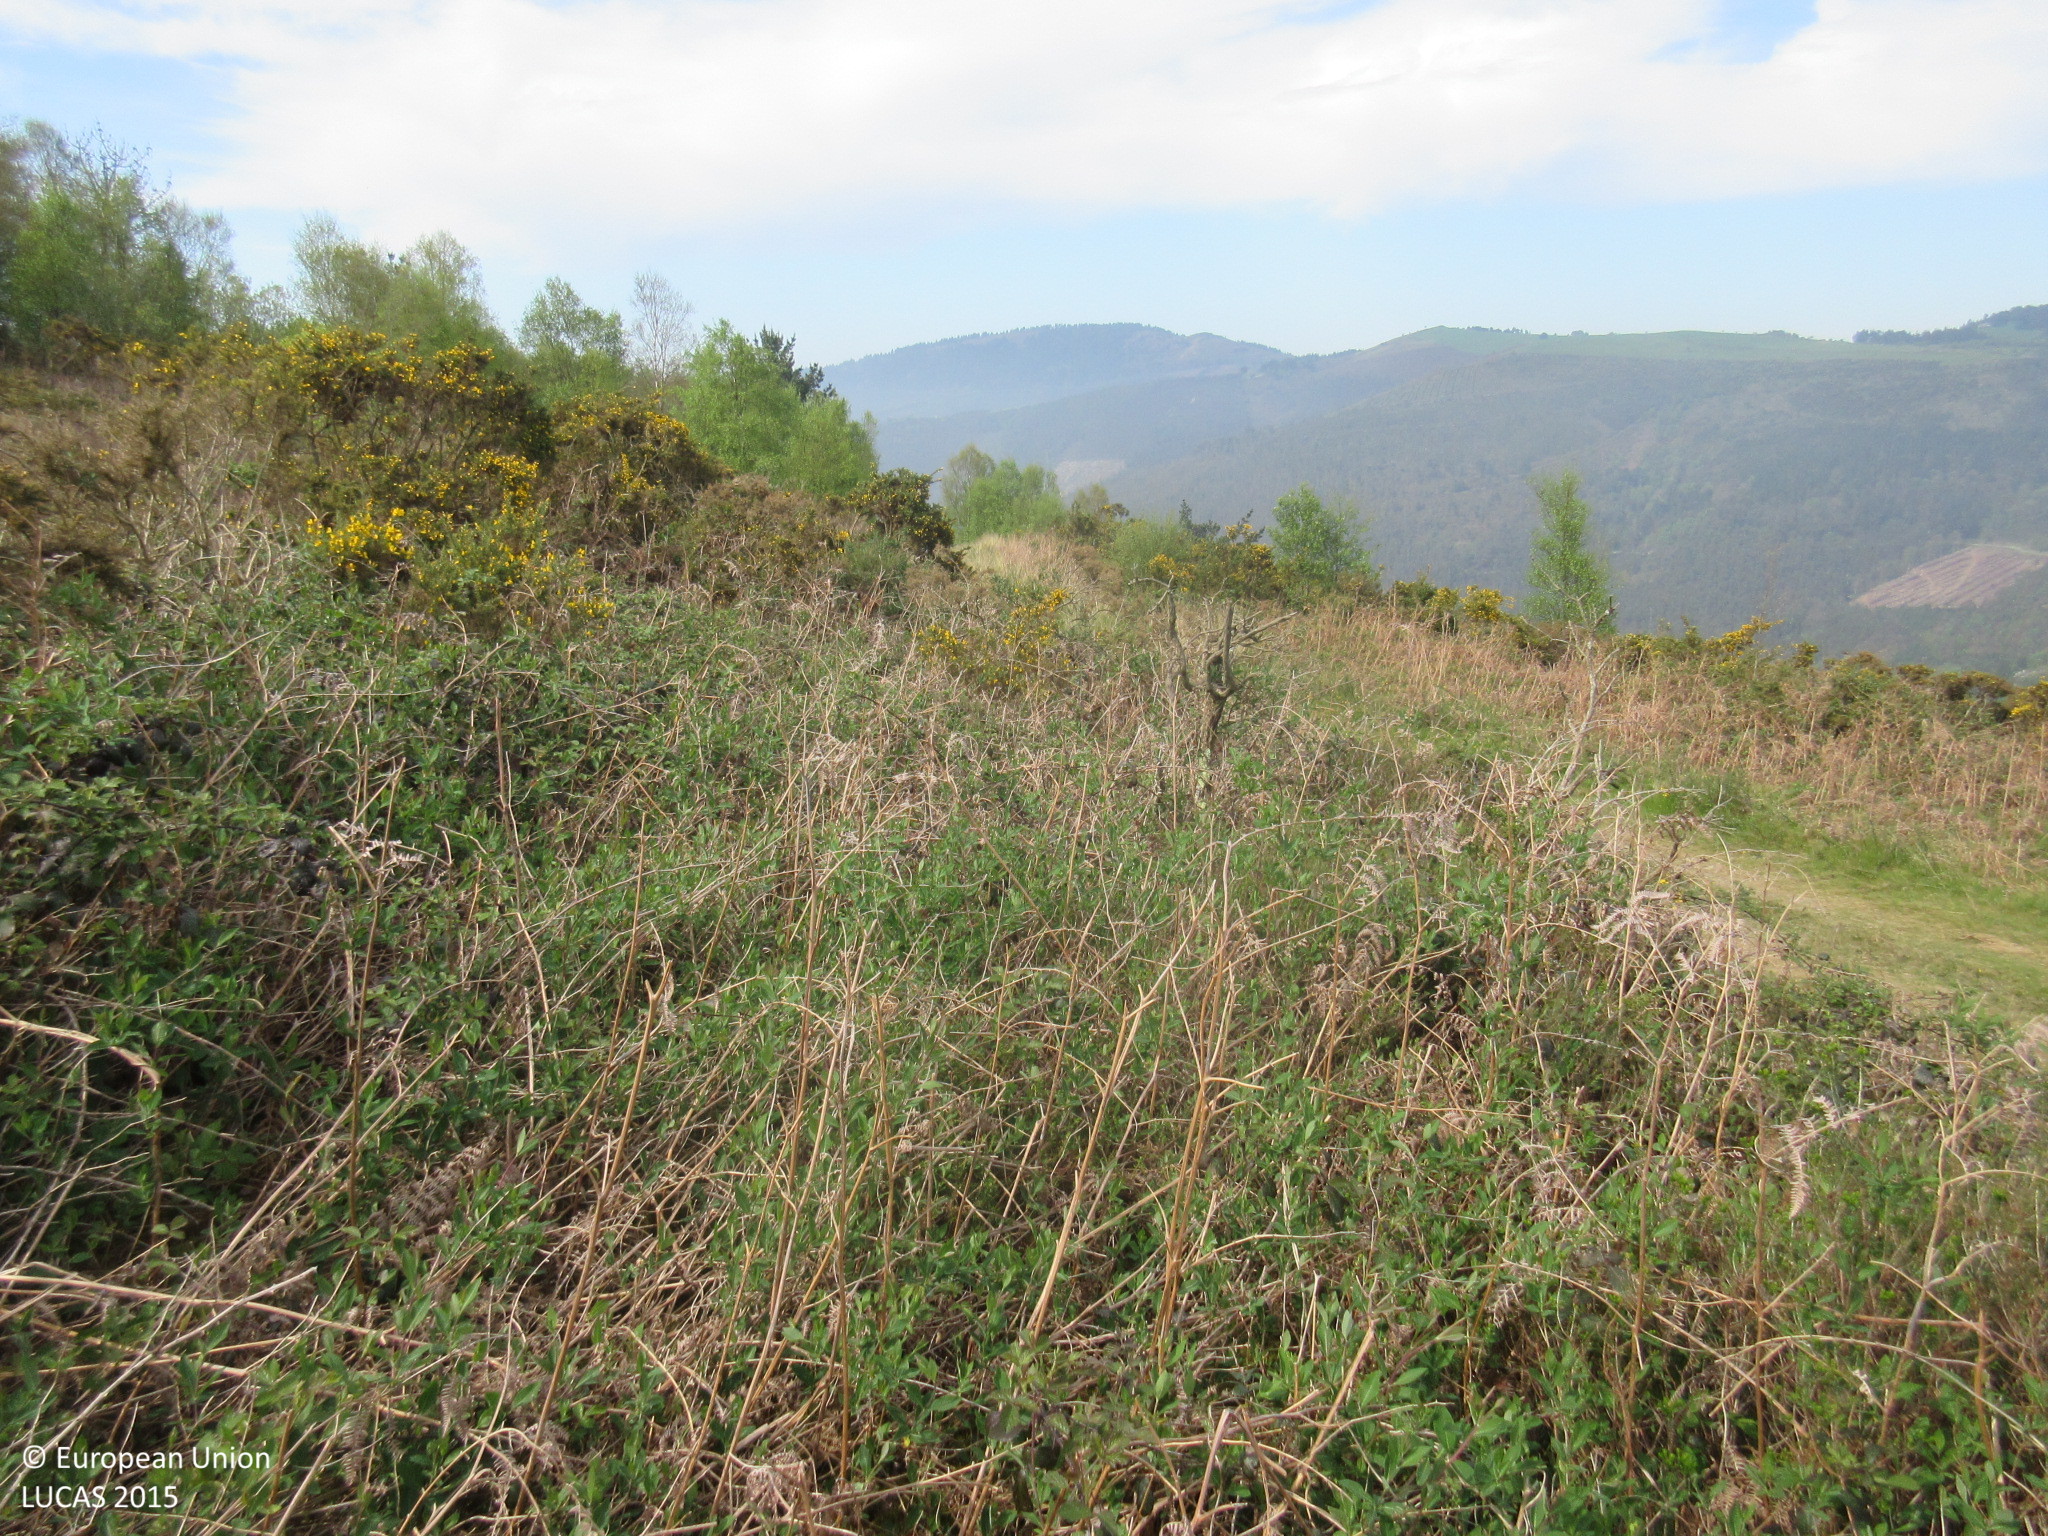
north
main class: Shrubland
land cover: Shrubland without tree cover
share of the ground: > 75 %
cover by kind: shrubs 100 %
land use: Semi-natural and natural areas not in use
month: April
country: ES
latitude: 43.4396
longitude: -6.9556
